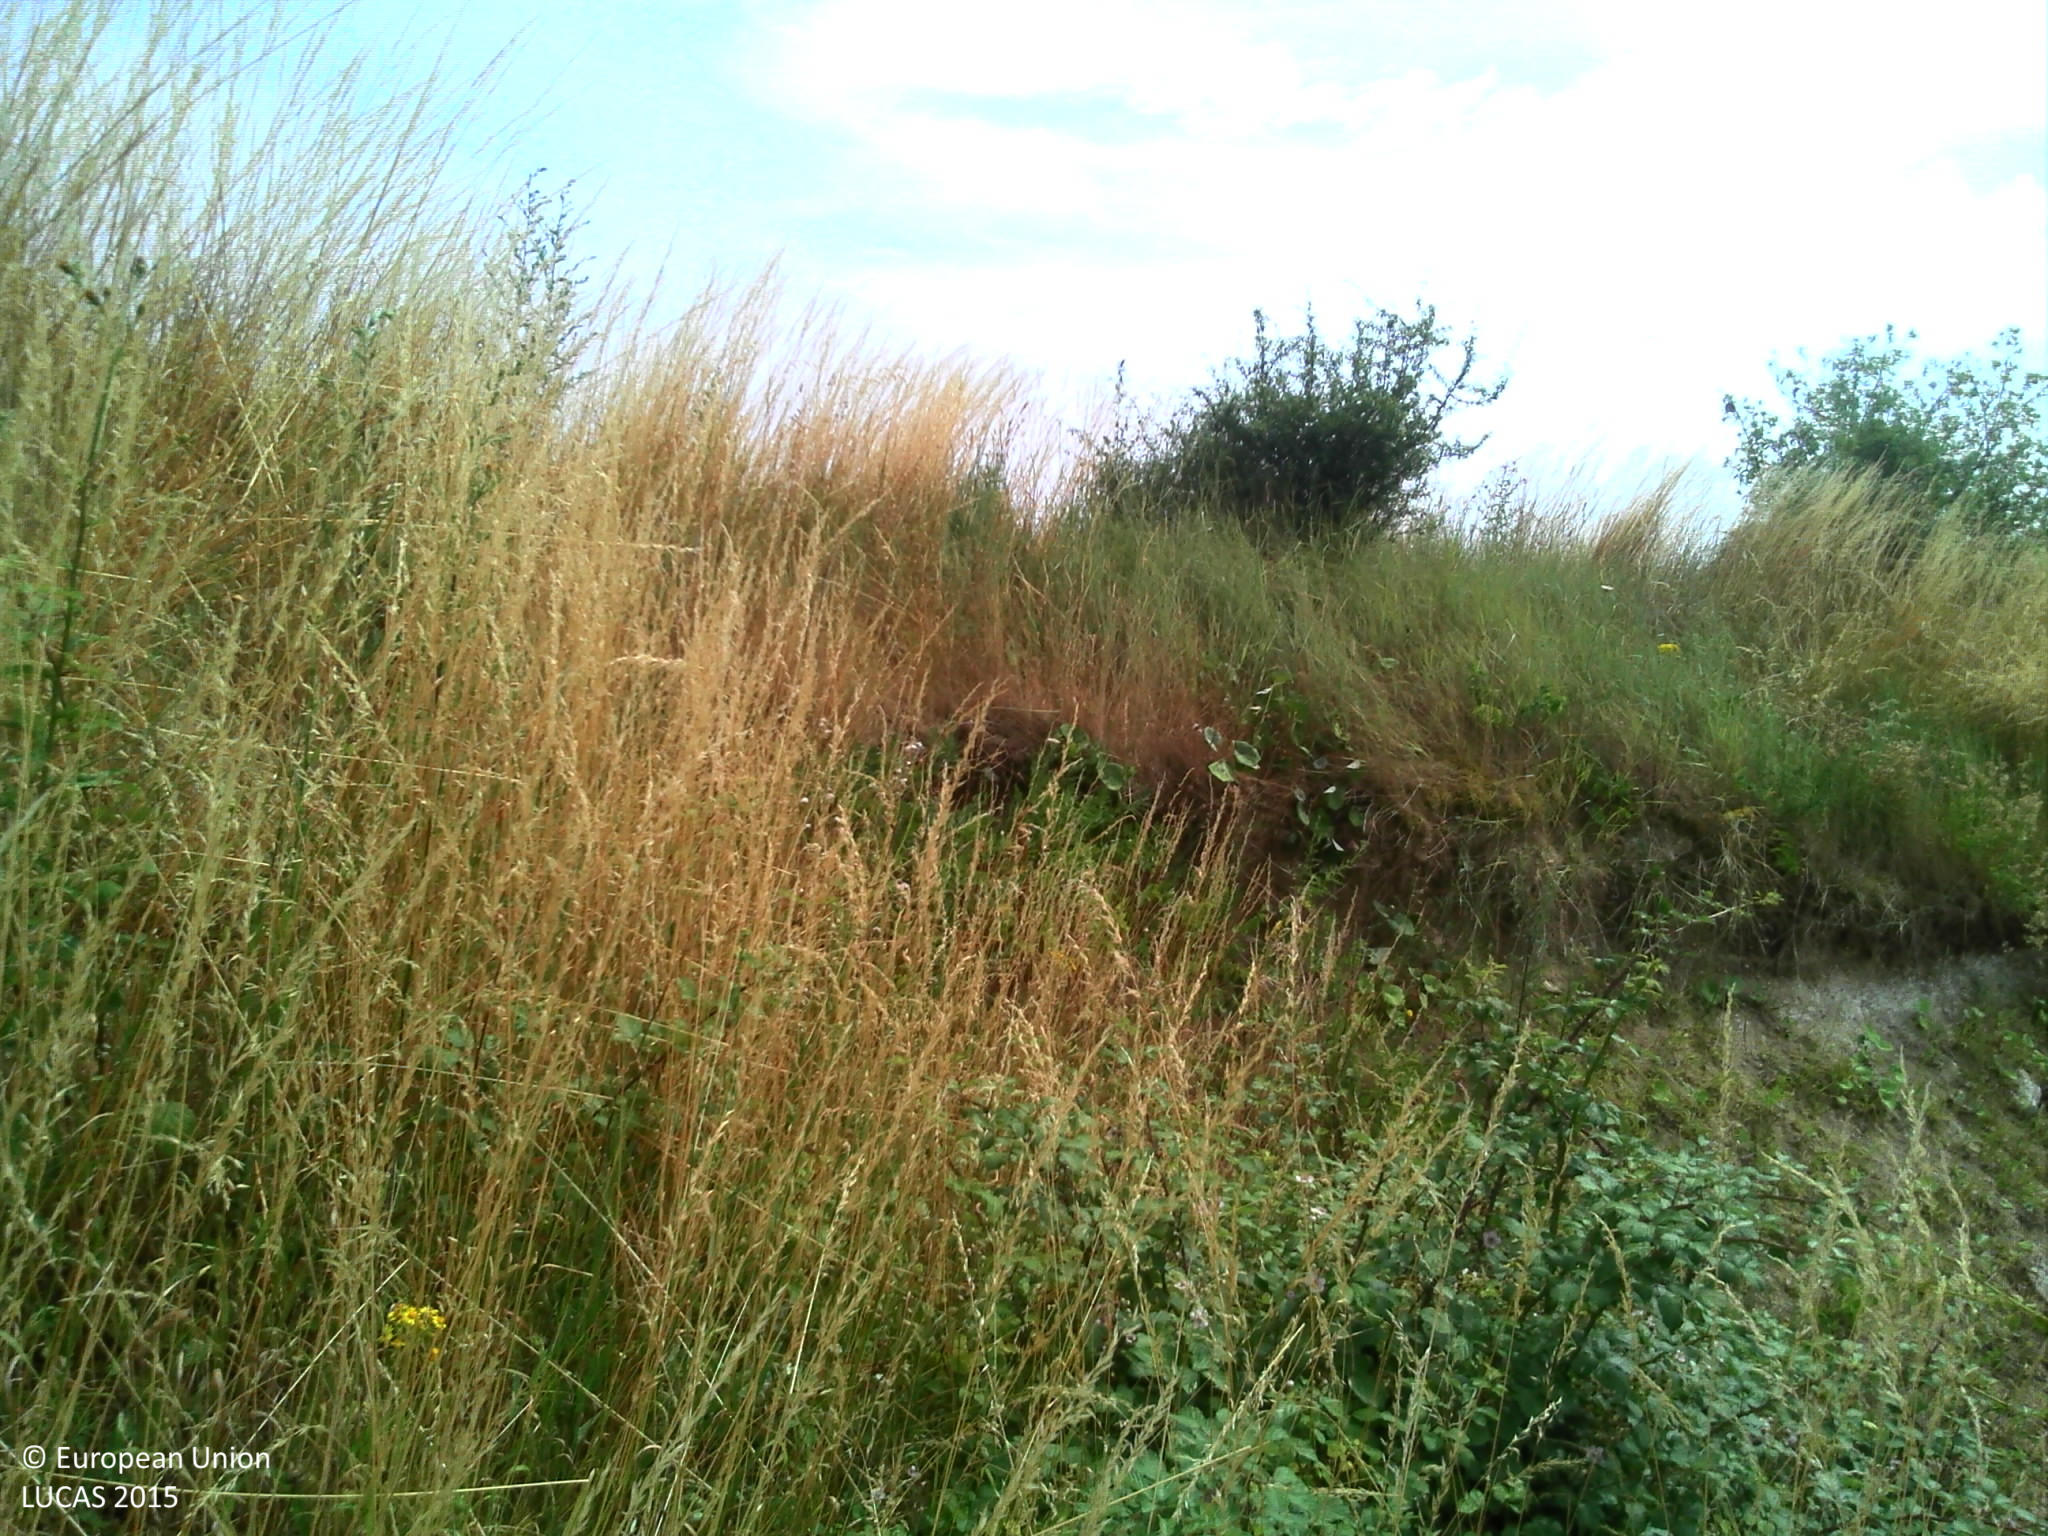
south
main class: Grassland
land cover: Spontaneously vegetated surfaces
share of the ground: > 75 %
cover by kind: herbaceous plants 100 %
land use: Mining and quarrying
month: July
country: FR
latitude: 47.8965
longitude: 2.7826
